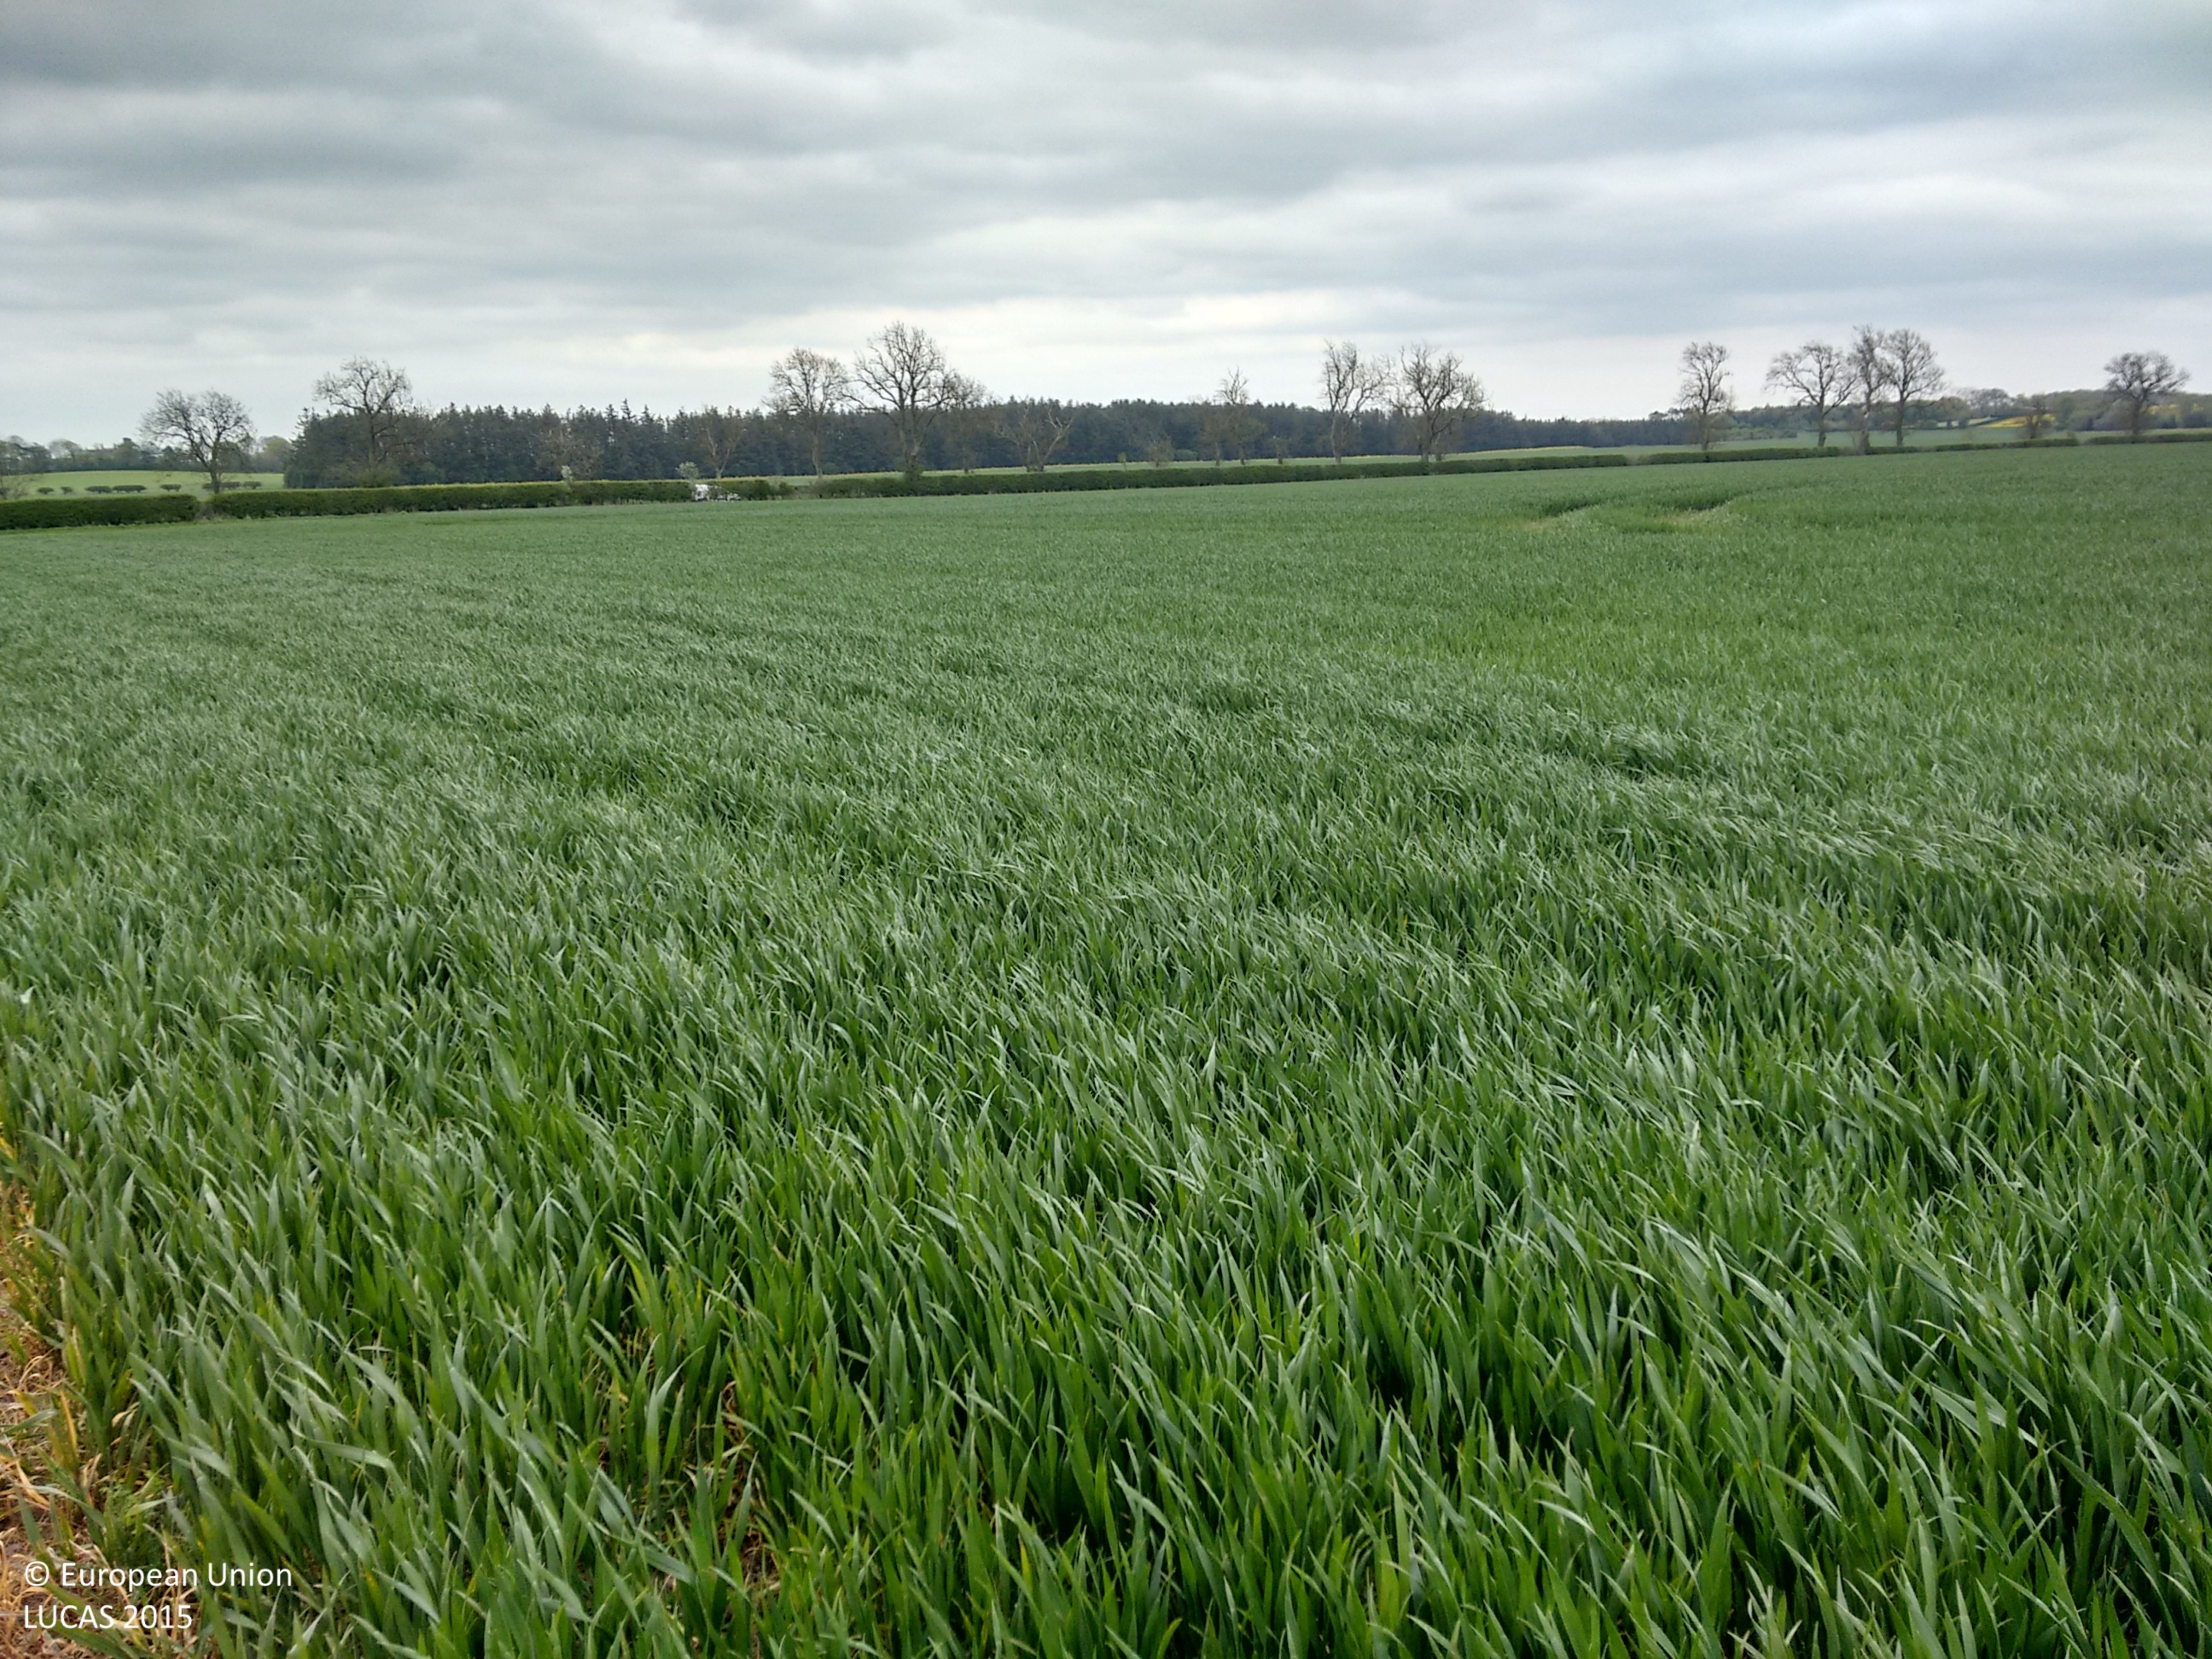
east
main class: Cropland
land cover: Common wheat
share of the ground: > 75 %
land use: Agriculture (excluding fallow land and kitchen gardens)
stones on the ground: < 10 %
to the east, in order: Common wheat; Grassland without tree/shrub cover; Managed hedges; Single bushes/trees; Grass margins; Paved roads, cycling and walking lanes; Grass margins; Lines of trees; Abandoned hedges; Grass margins; Barley
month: May
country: GB
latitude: 55.7031
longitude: -2.2939
